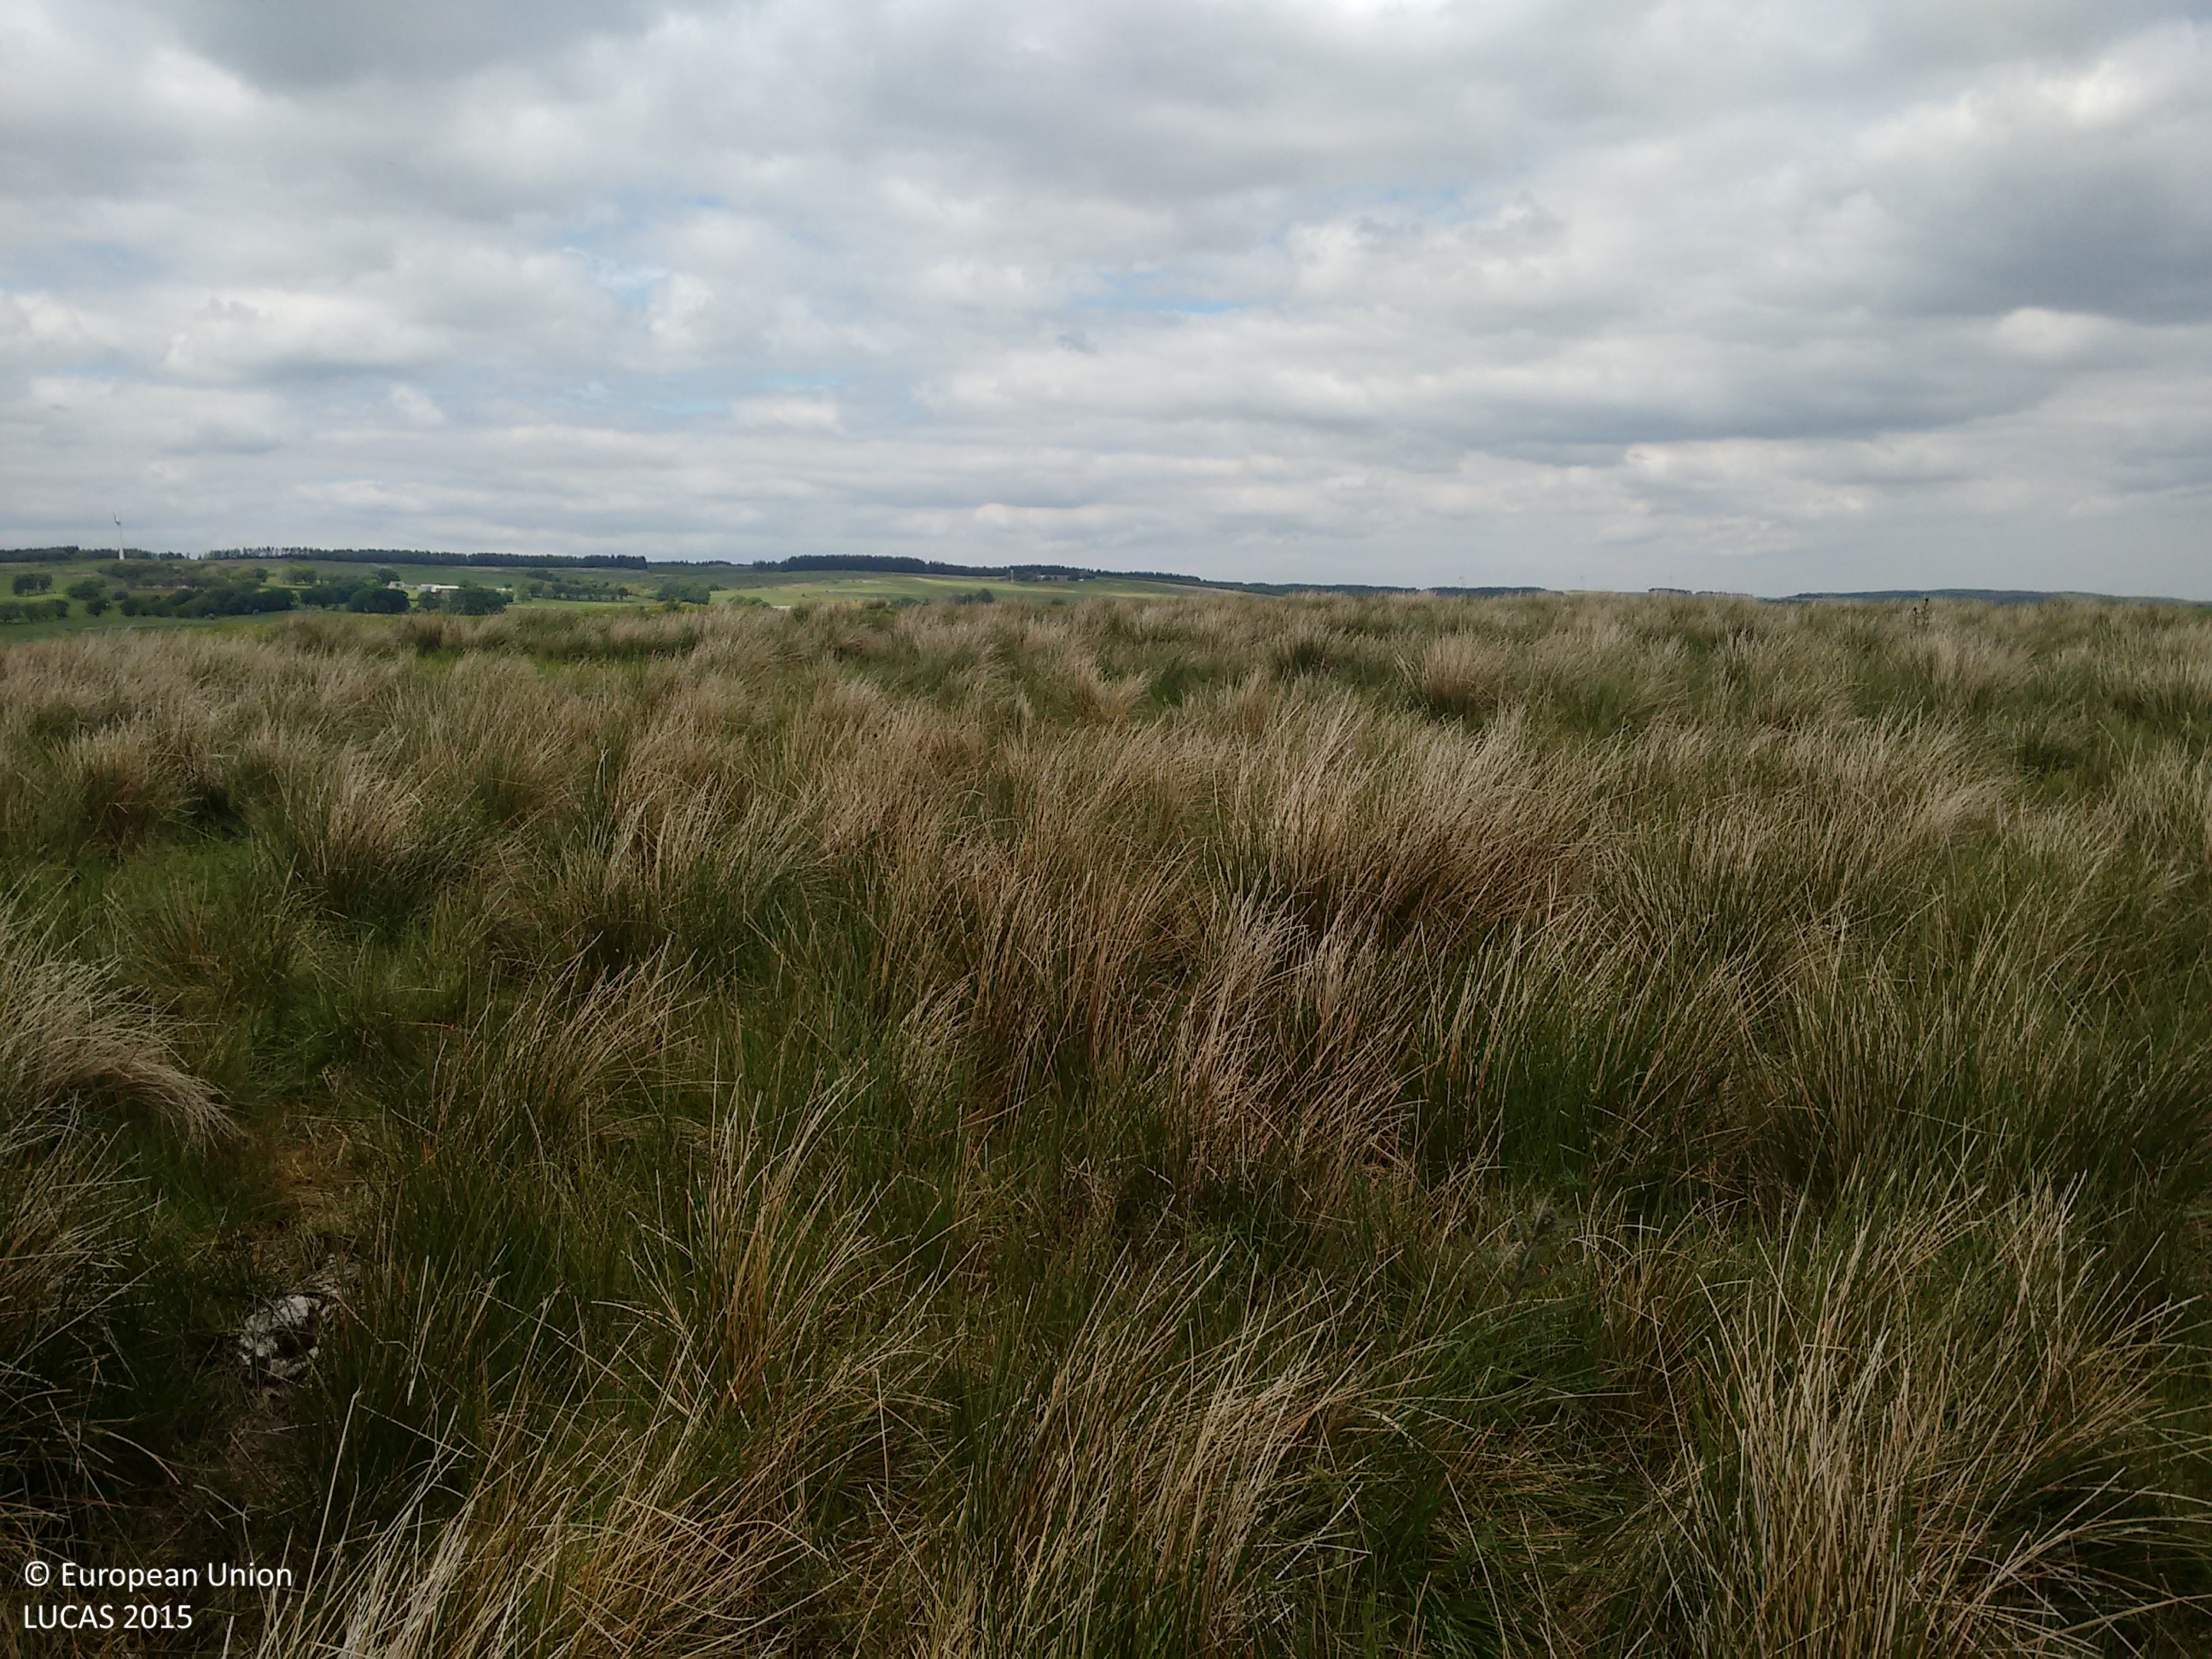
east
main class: Grassland
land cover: Grassland without tree/shrub cover
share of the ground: > 75 %
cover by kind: herbaceous plants 100 %
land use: Agriculture (excluding fallow land and kitchen gardens)
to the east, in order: Grassland without tree/shrub cover; Fences; Grassland without tree/shrub cover; Inland marshes; Grassland without tree/shrub cover
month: June
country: GB
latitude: 55.7648
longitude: -3.6441
